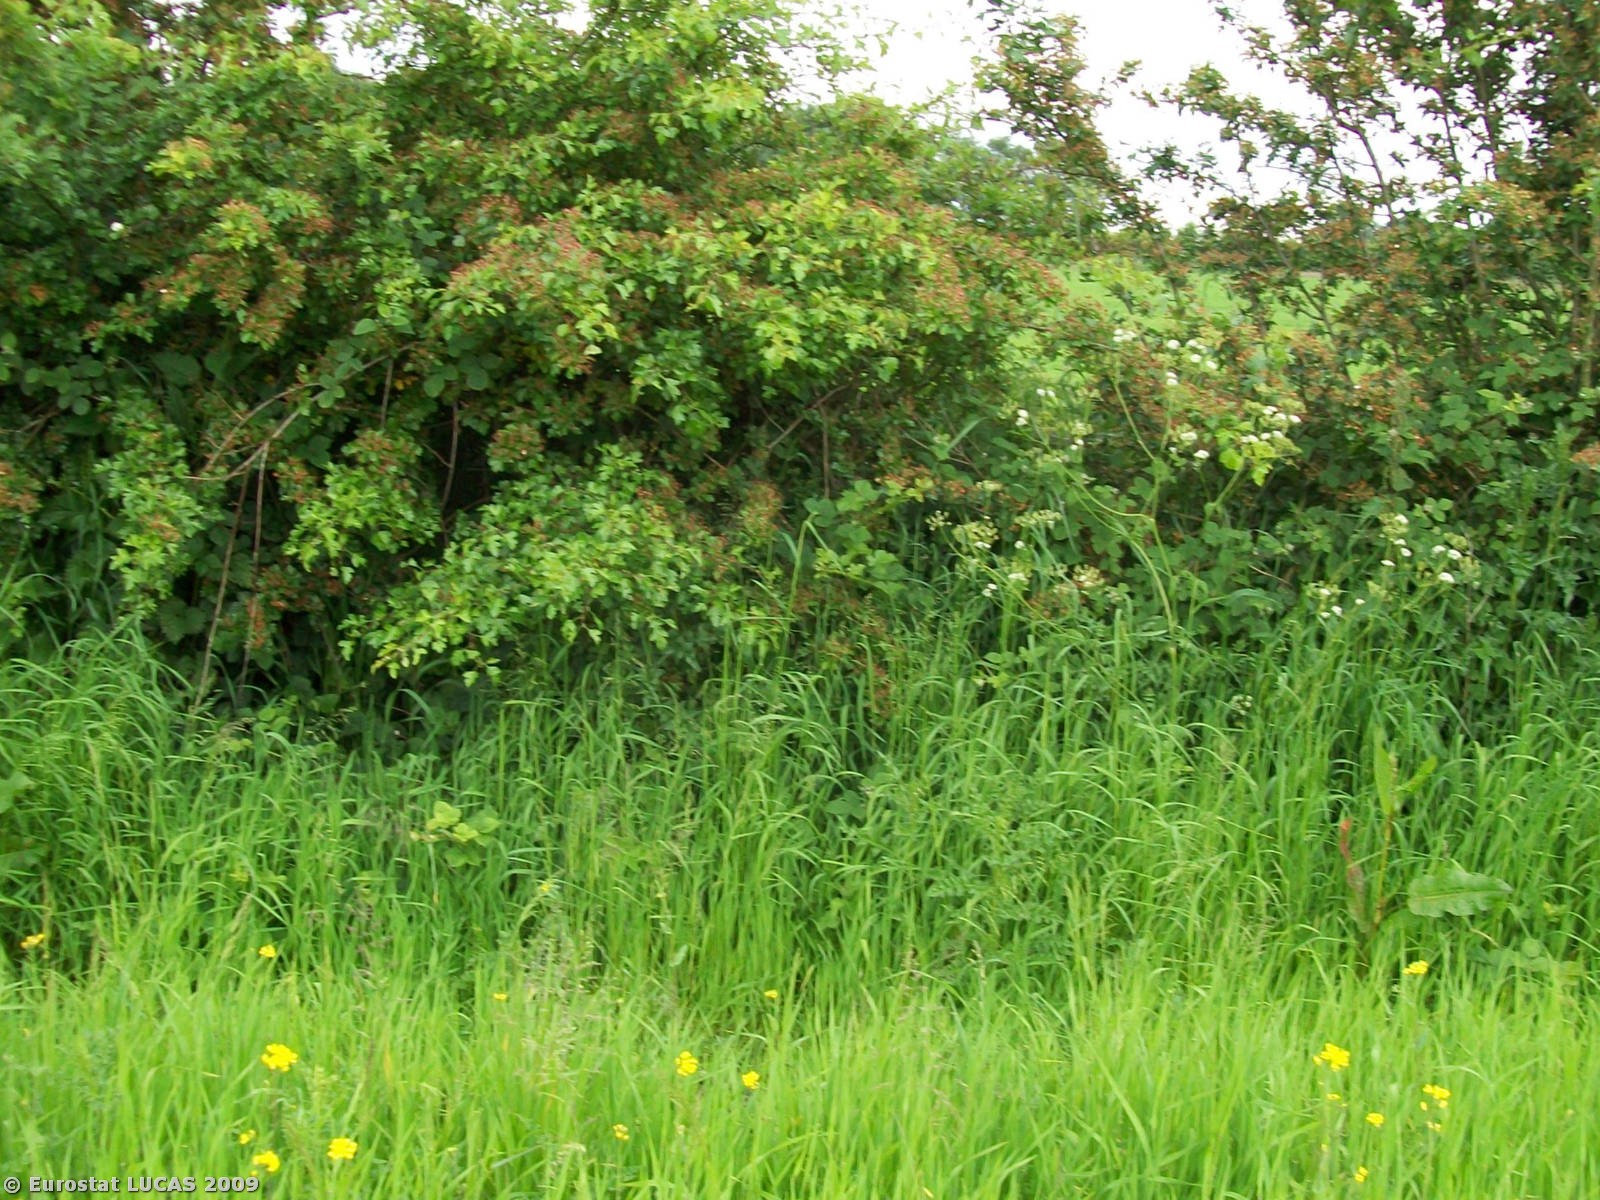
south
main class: Cropland
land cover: Barley
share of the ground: < 10 %
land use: Agriculture (excluding fallow land and kitchen gardens)
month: June
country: GB
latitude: 53.4483
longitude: -2.7938
